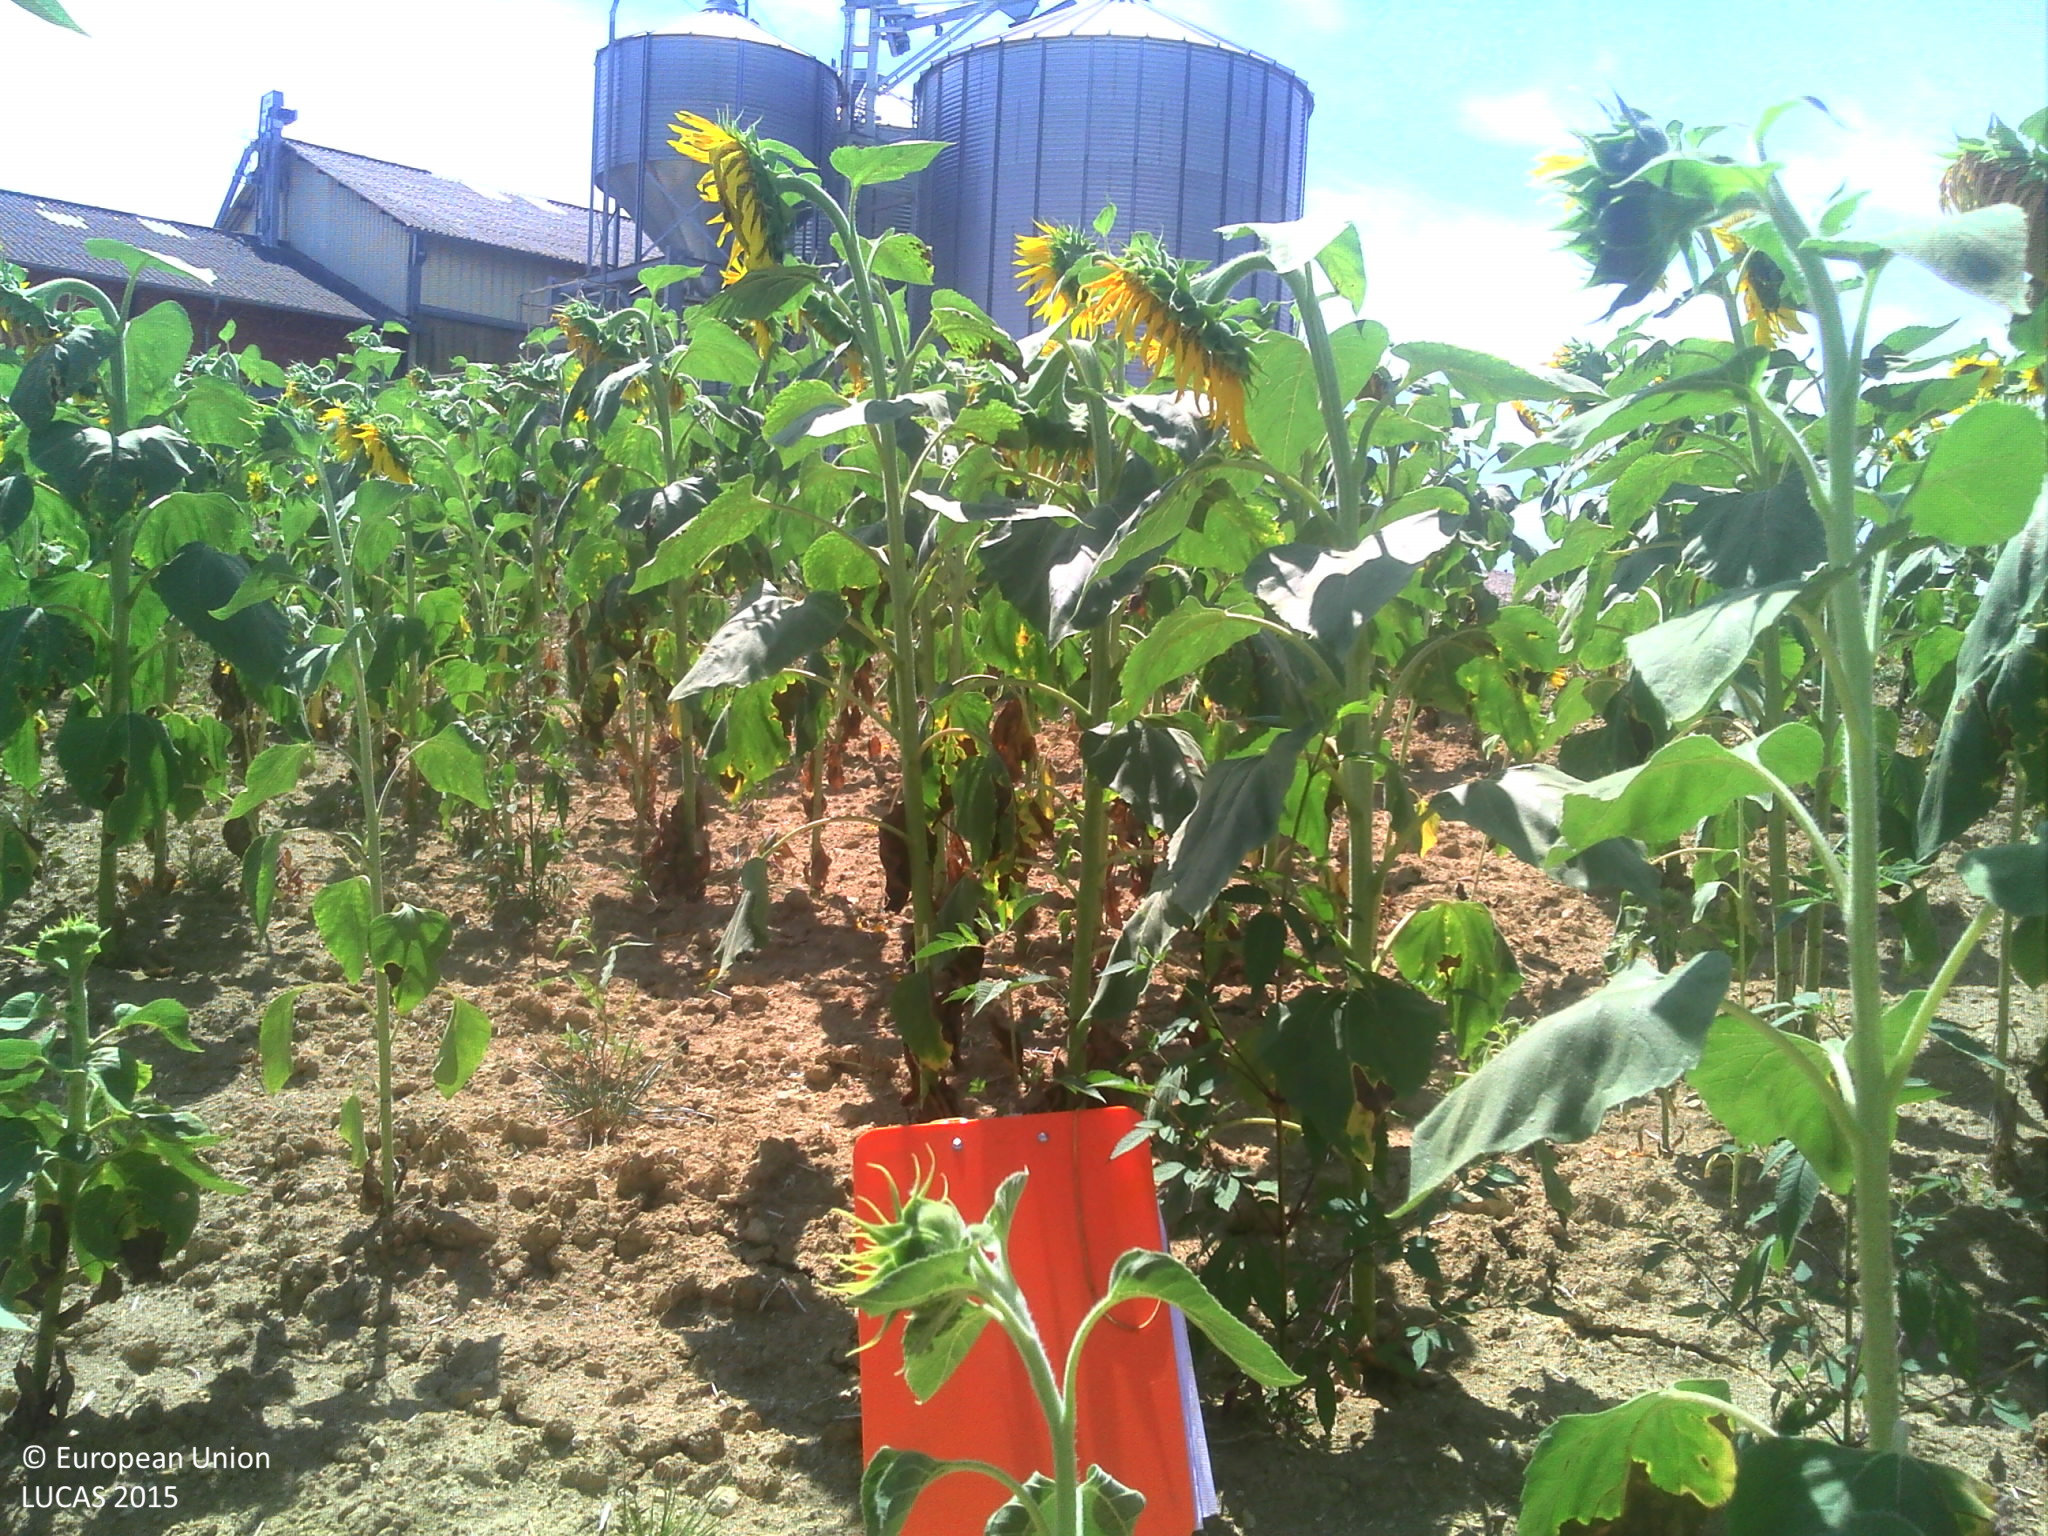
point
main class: Cropland
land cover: Sunflower
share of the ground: > 75 %
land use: Agriculture (excluding fallow land and kitchen gardens)
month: July
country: FR
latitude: 43.3565
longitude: 1.3792
